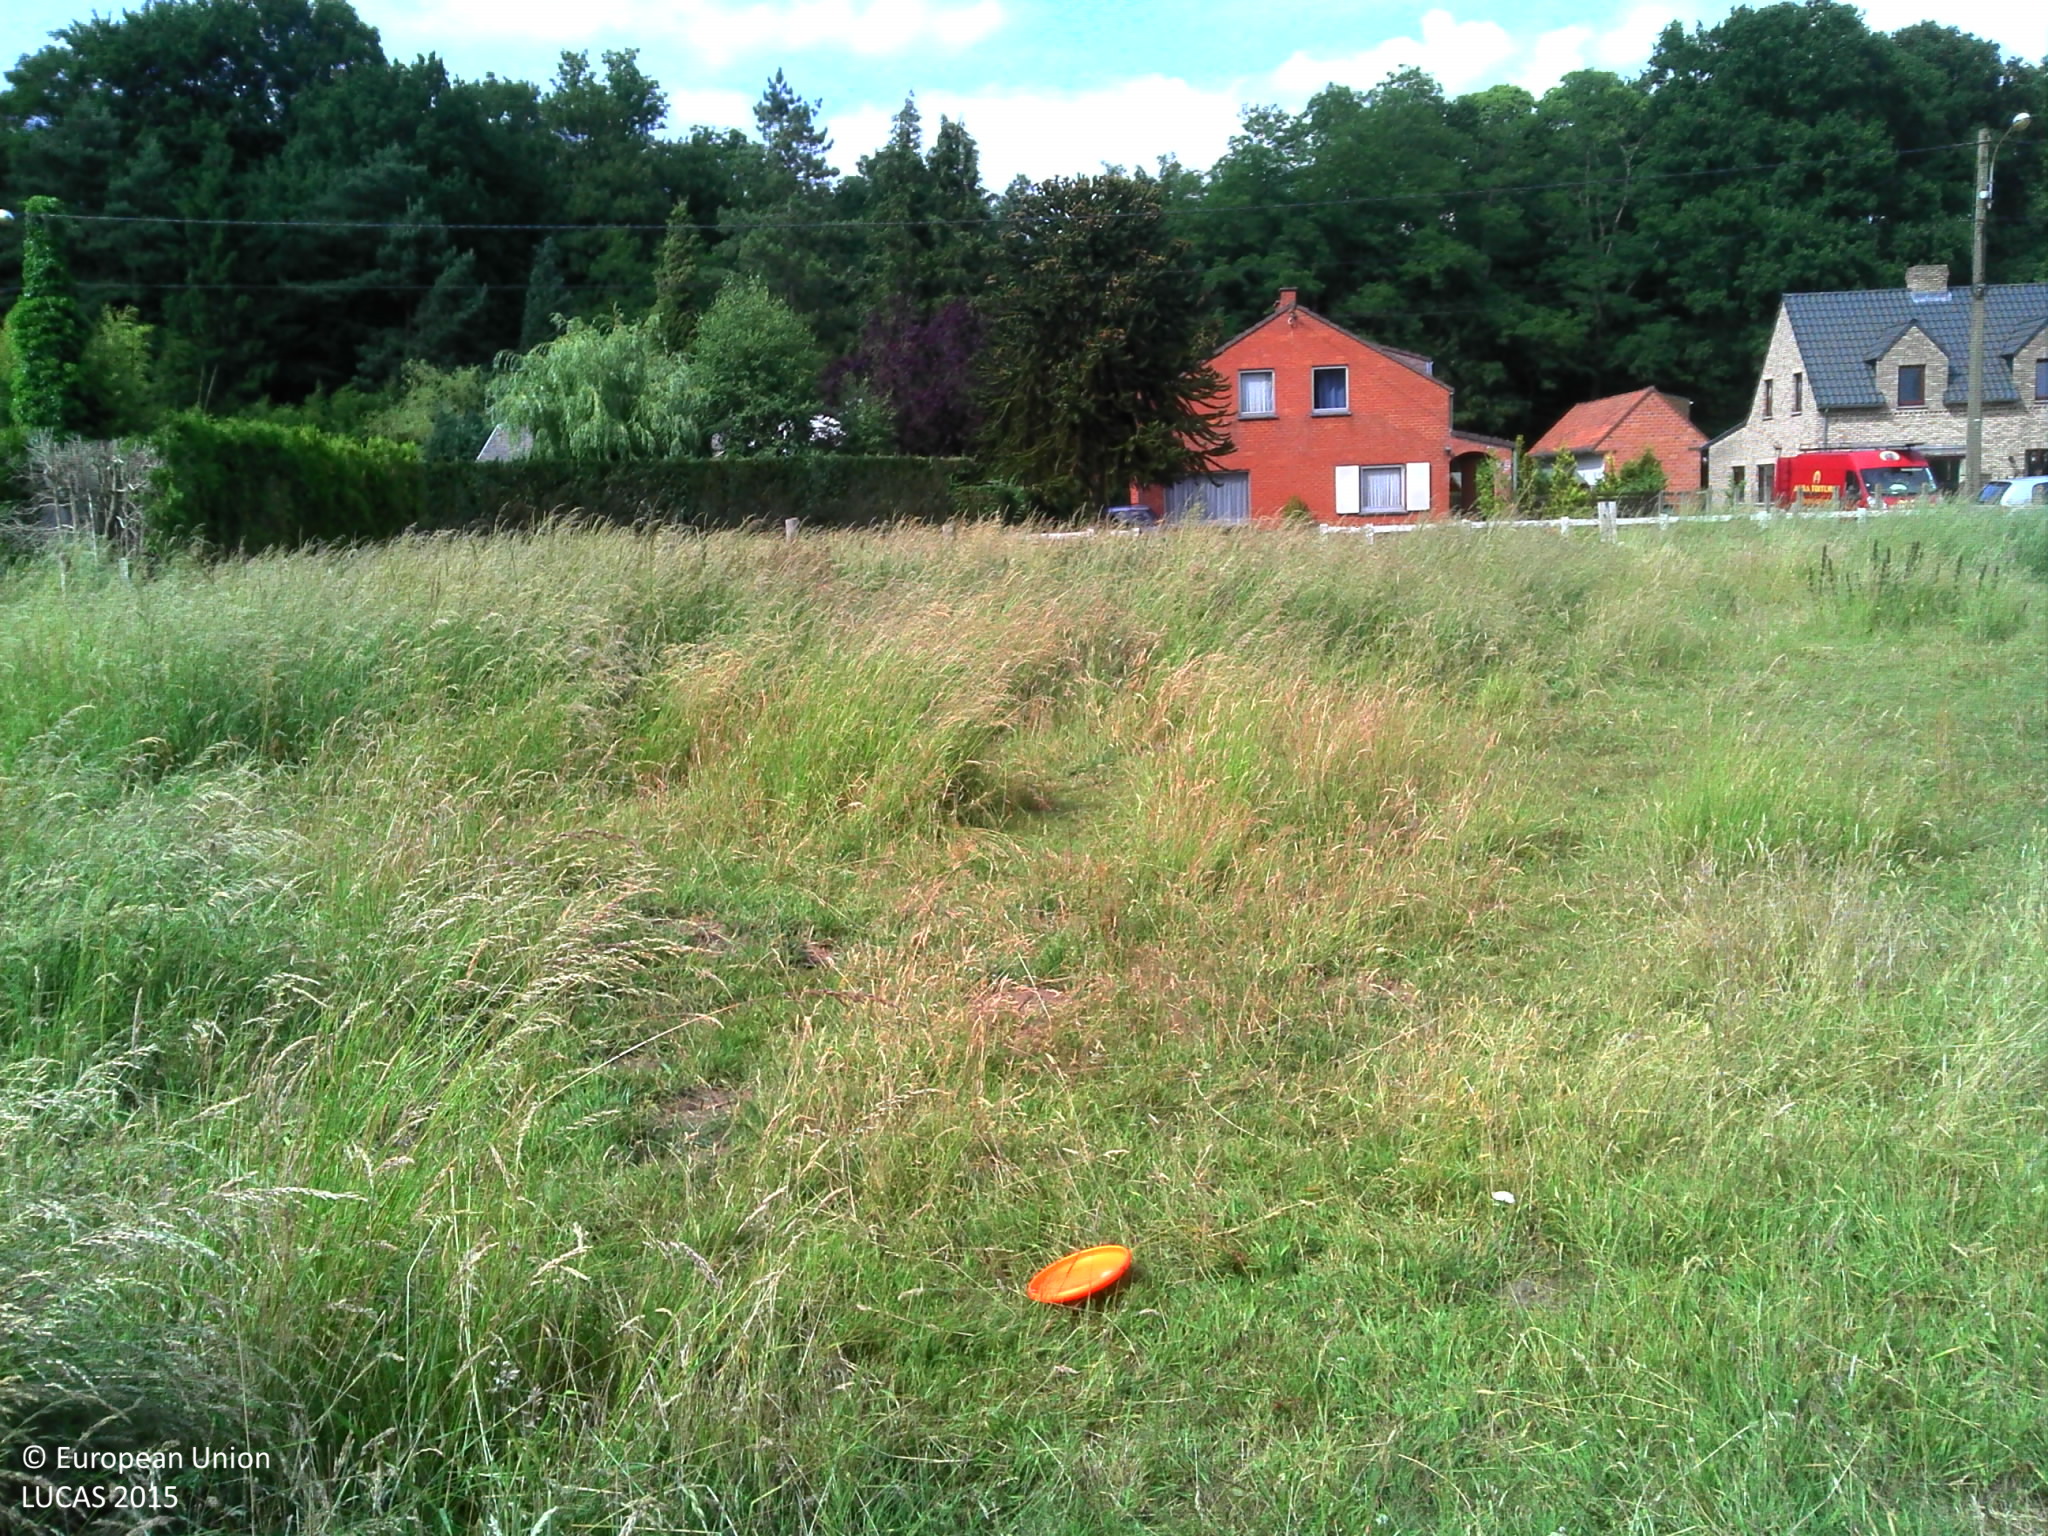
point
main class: Grassland
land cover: Grassland without tree/shrub cover
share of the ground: > 75 %
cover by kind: herbaceous plants 100 %
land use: Agriculture (excluding fallow land and kitchen gardens)
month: June
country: BE
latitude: 50.4908
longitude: 3.9187
